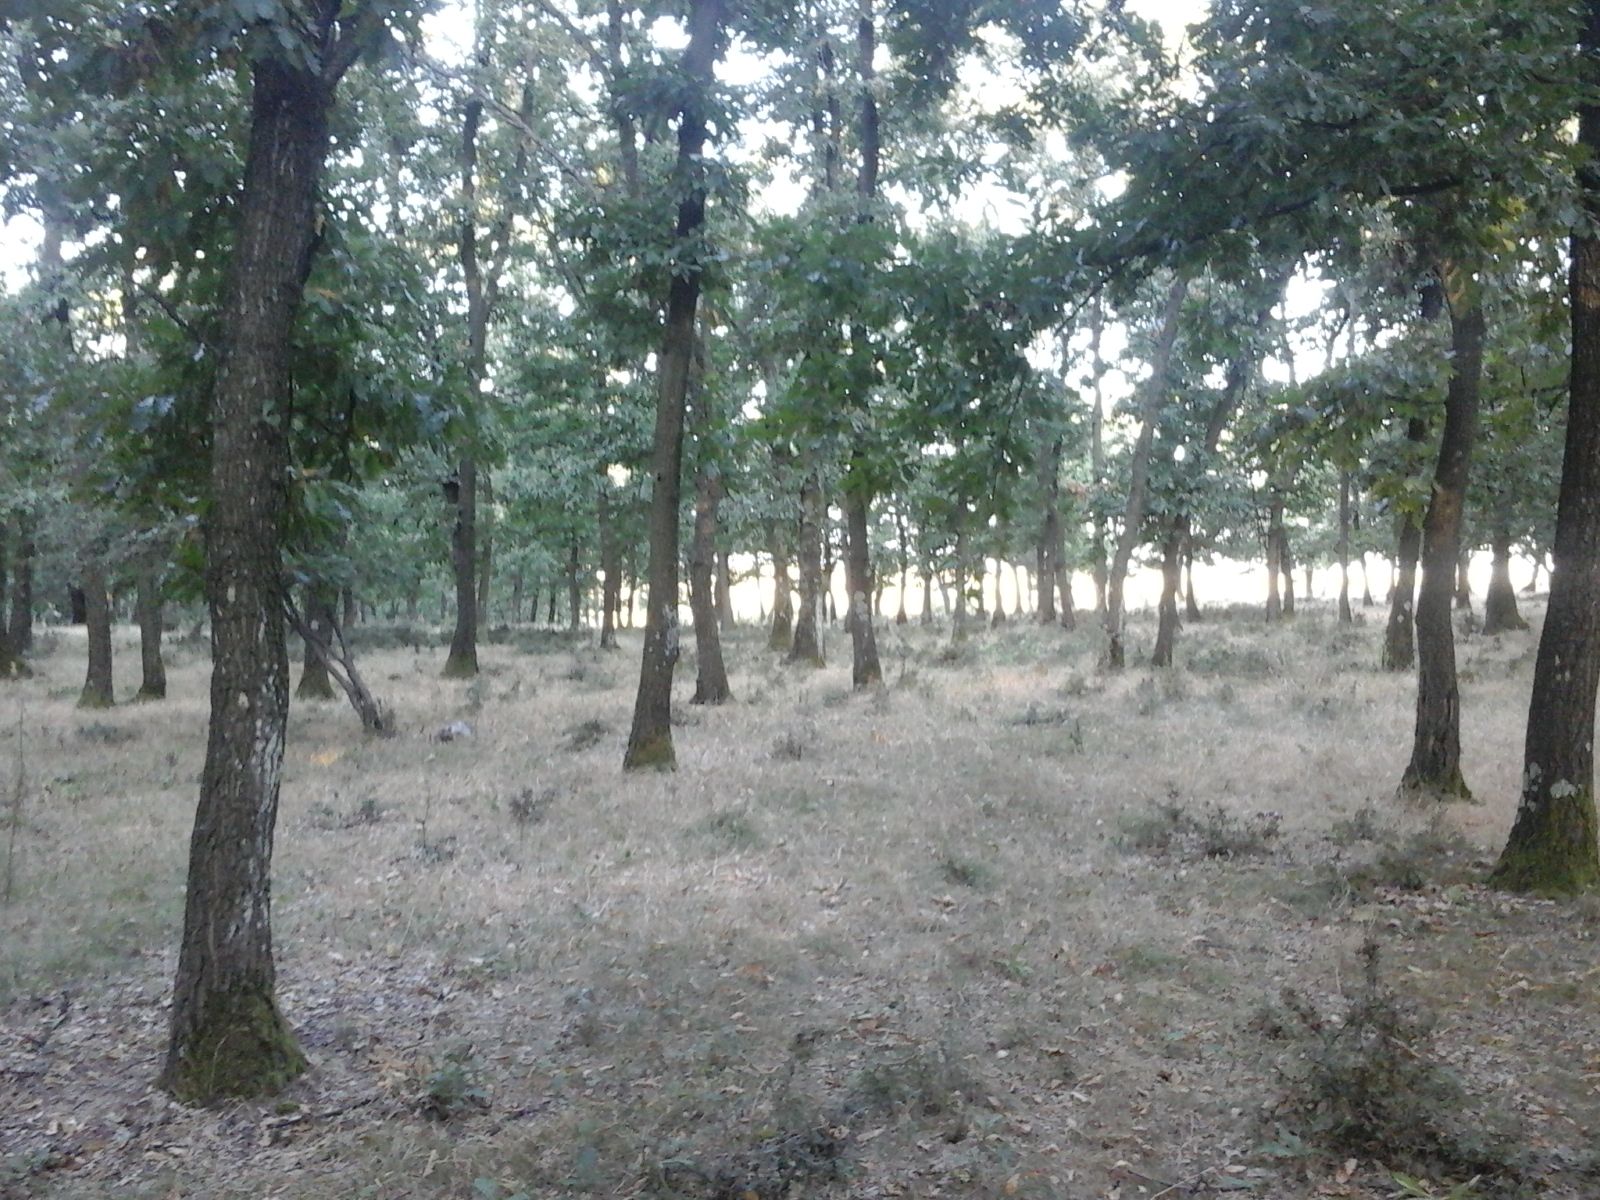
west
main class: Woodland
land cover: Broadleaved woodland
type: acidophilous oak and oak-birch forest
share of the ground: > 75 %
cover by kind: broadleaved forest trees 100 %
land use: Forestry
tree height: > 5 m
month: August
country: RO
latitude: 44.1936
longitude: 23.7807
